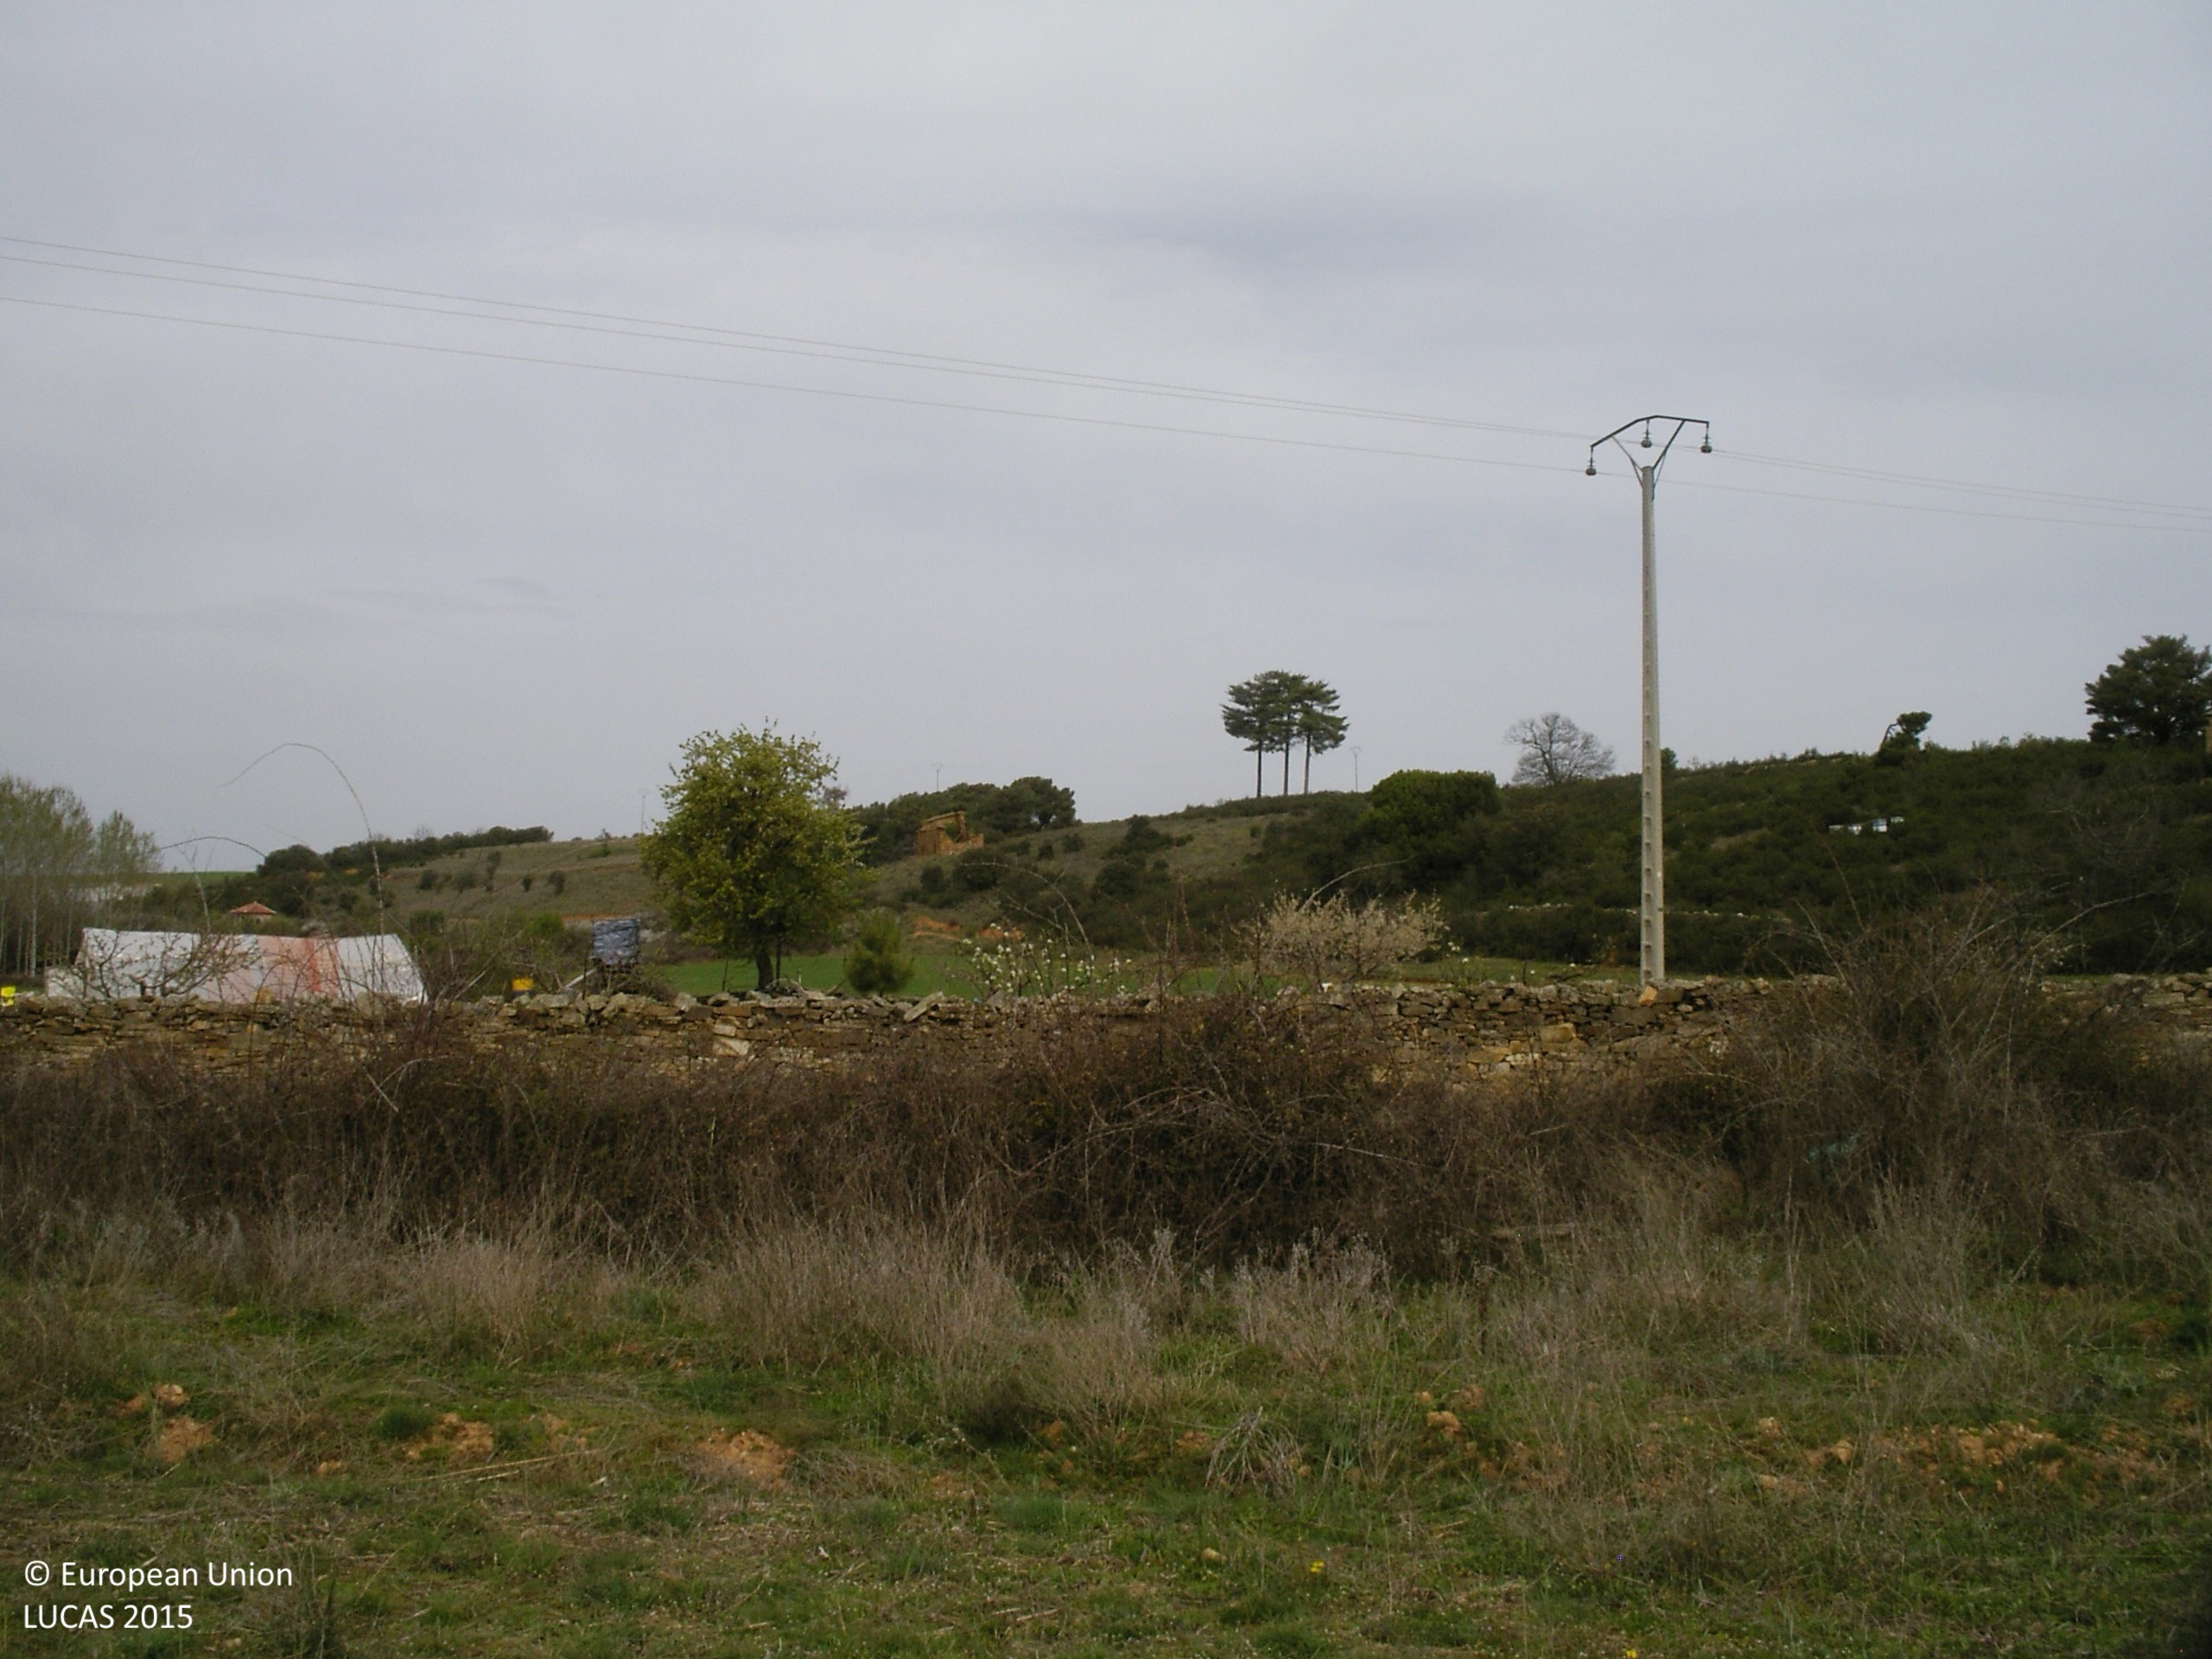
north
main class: Grassland
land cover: Grassland with sparse tree/shrub cover
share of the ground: > 75 %
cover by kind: herbaceous plants 90 %, coniferous forest trees 5 %, shrubs 5 %
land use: Agriculture (excluding fallow land and kitchen gardens)
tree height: < 5 m
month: April
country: ES
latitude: 42.4201
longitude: -6.1122
